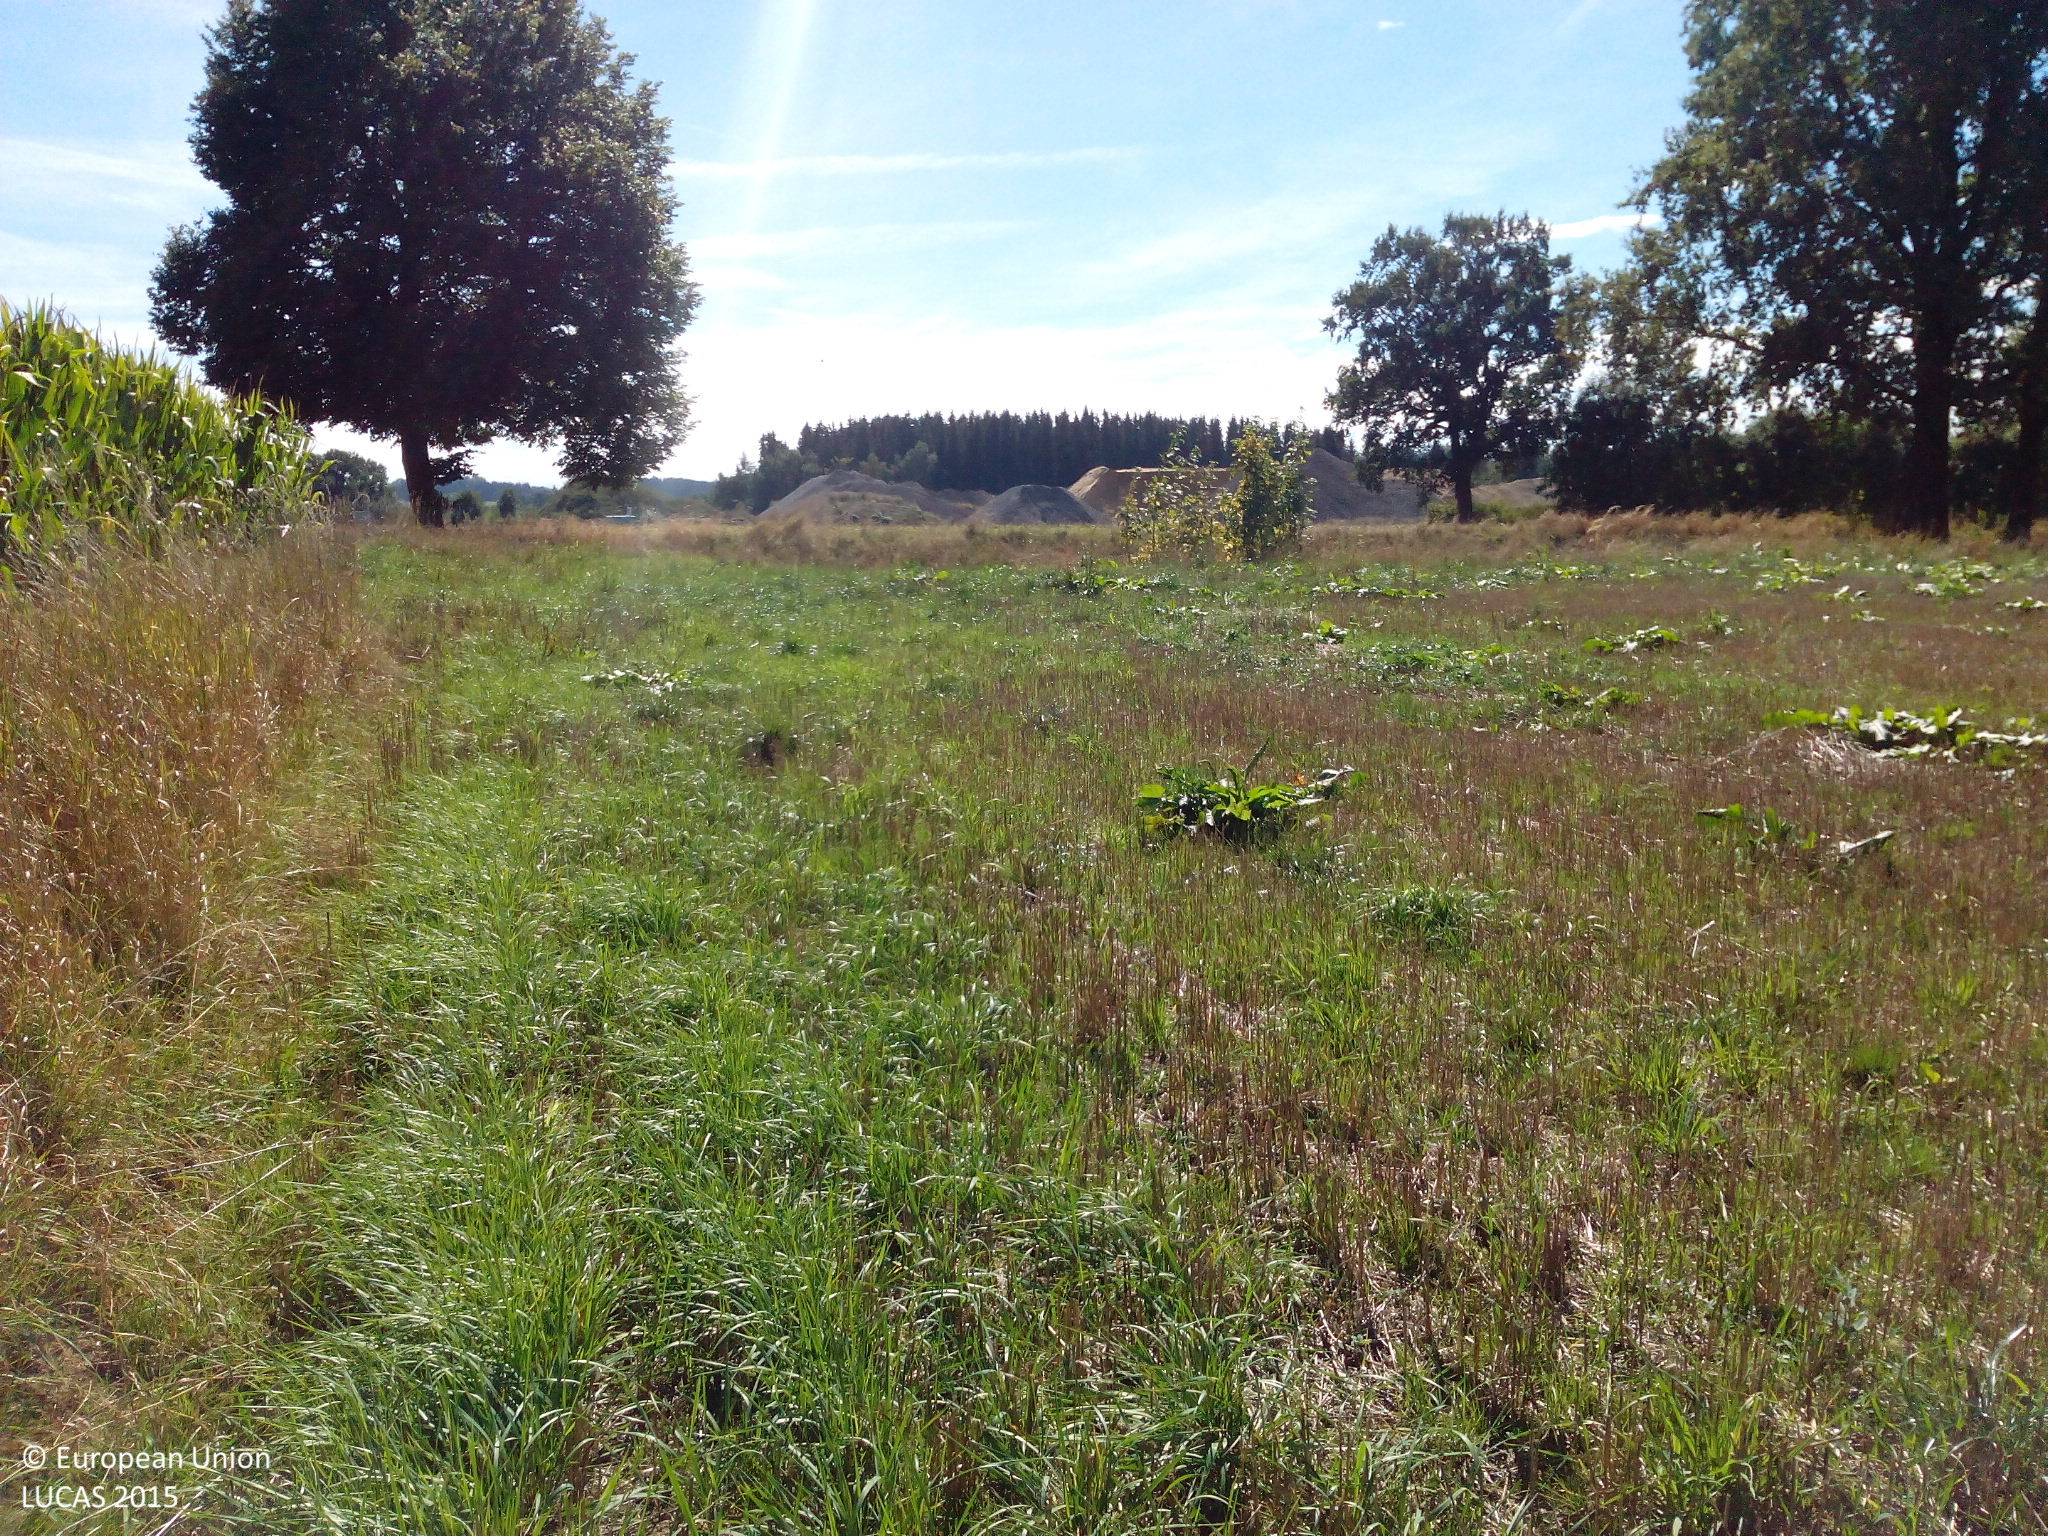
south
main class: Cropland
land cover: Maize
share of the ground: > 75 %
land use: Agriculture (excluding fallow land and kitchen gardens)
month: September
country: DE
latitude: 48.3842
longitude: 12.0650
